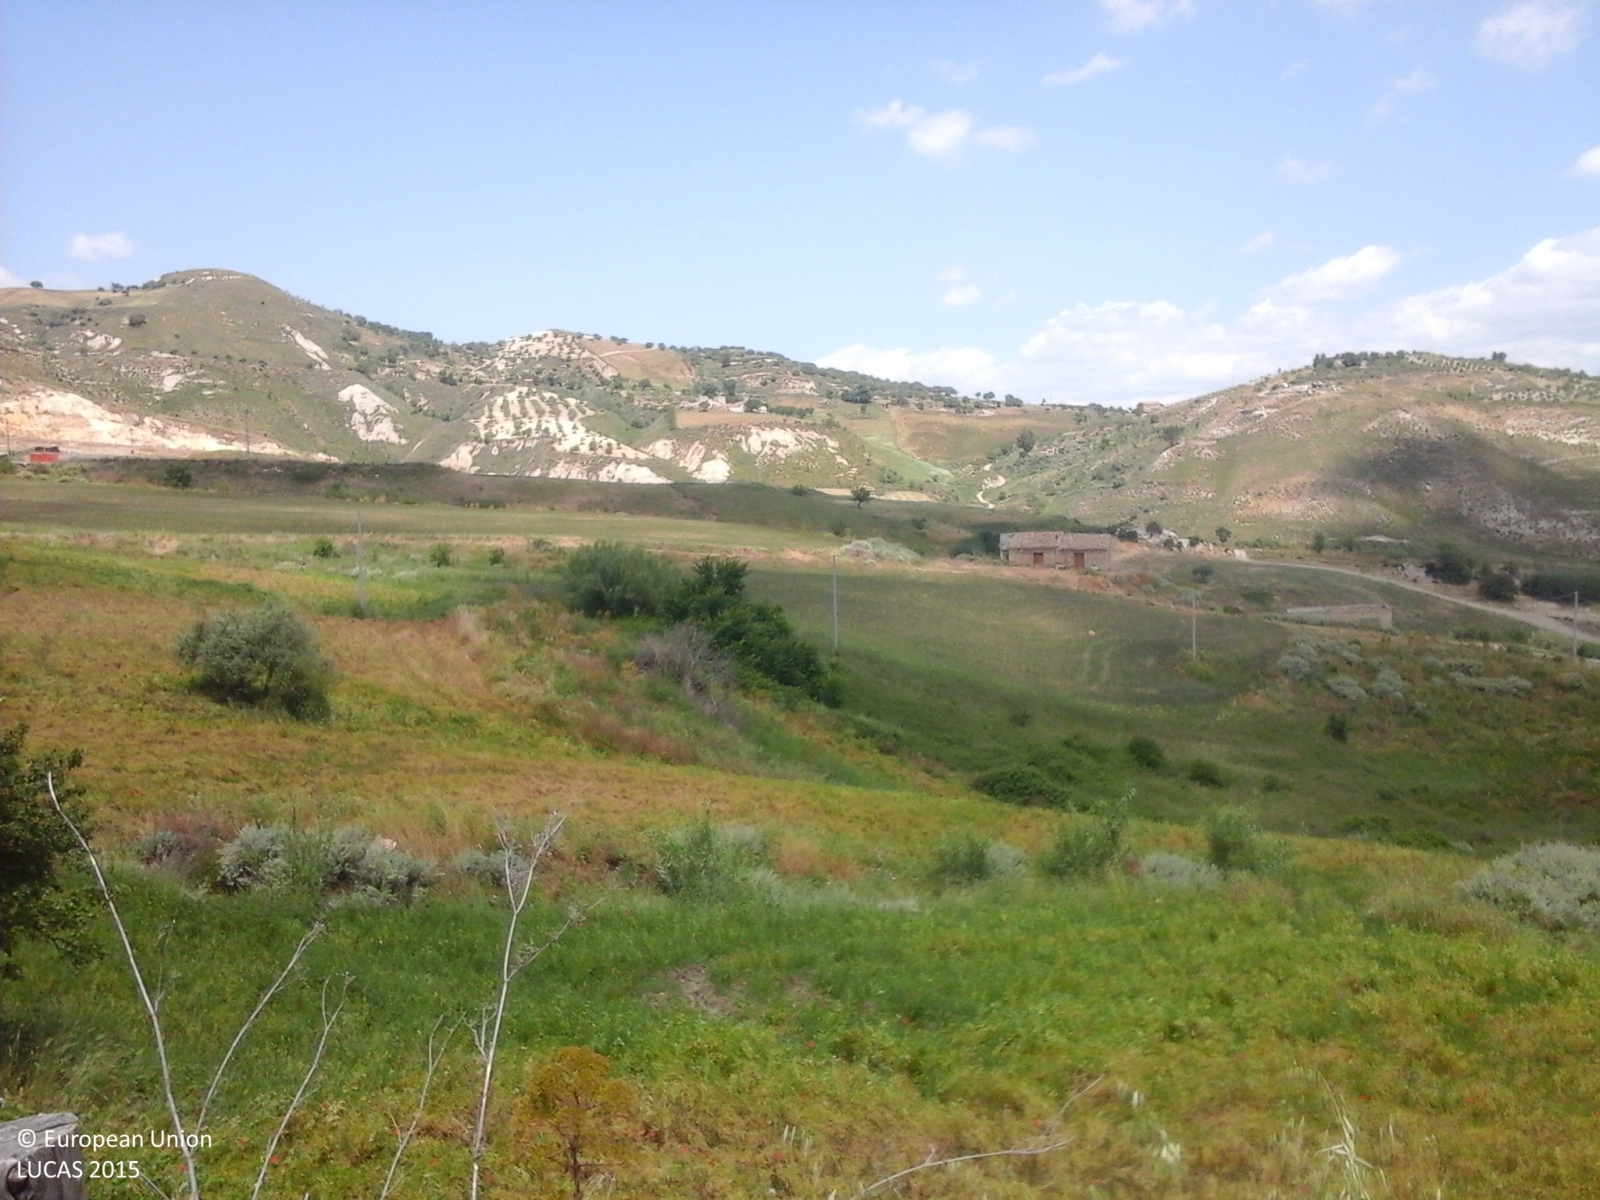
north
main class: Grassland
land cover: Grassland with sparse tree/shrub cover
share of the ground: > 75 %
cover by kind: herbaceous plants 85 %, shrubs 10 %, coniferous forest trees 5 %
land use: Agriculture (excluding fallow land and kitchen gardens)
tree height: < 5 m
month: May
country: IT
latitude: 37.6186
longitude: 14.1952
